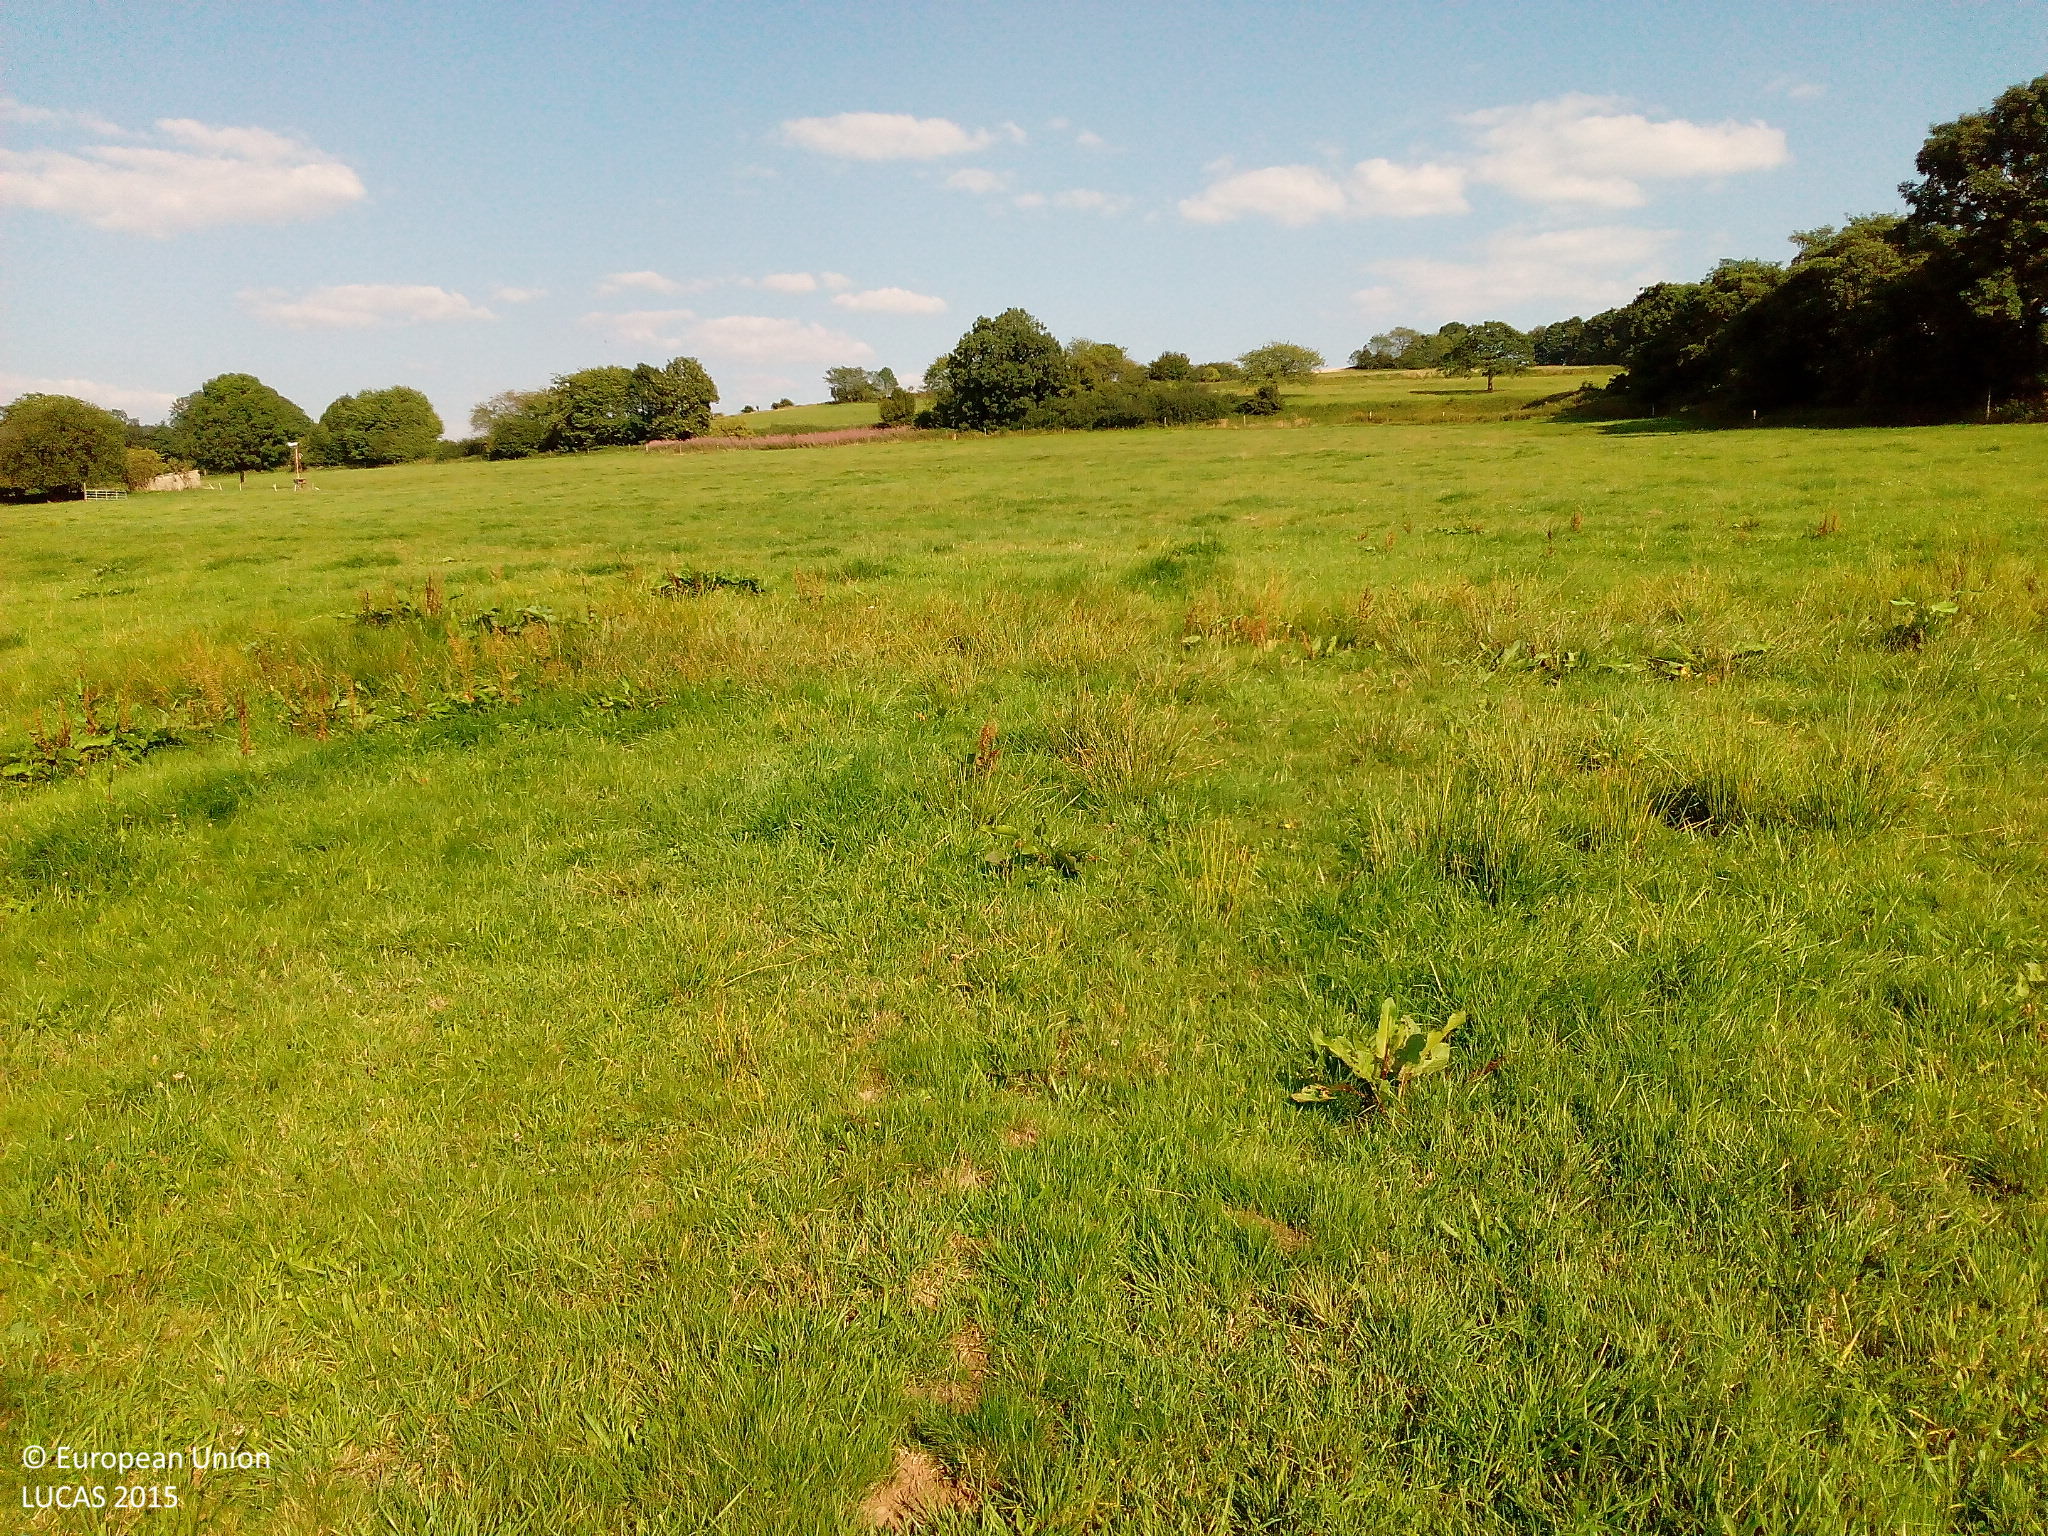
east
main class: Grassland
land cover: Grassland without tree/shrub cover
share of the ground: > 75 %
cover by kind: herbaceous plants 100 %
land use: Agriculture (excluding fallow land and kitchen gardens)
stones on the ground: < 10 %
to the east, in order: Grassland without tree/shrub cover; Fences; Grassland with sparse tree/shrub cover; Paved roads, cycling and walking lanes
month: August
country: DE
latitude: 50.5049
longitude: 9.1684
